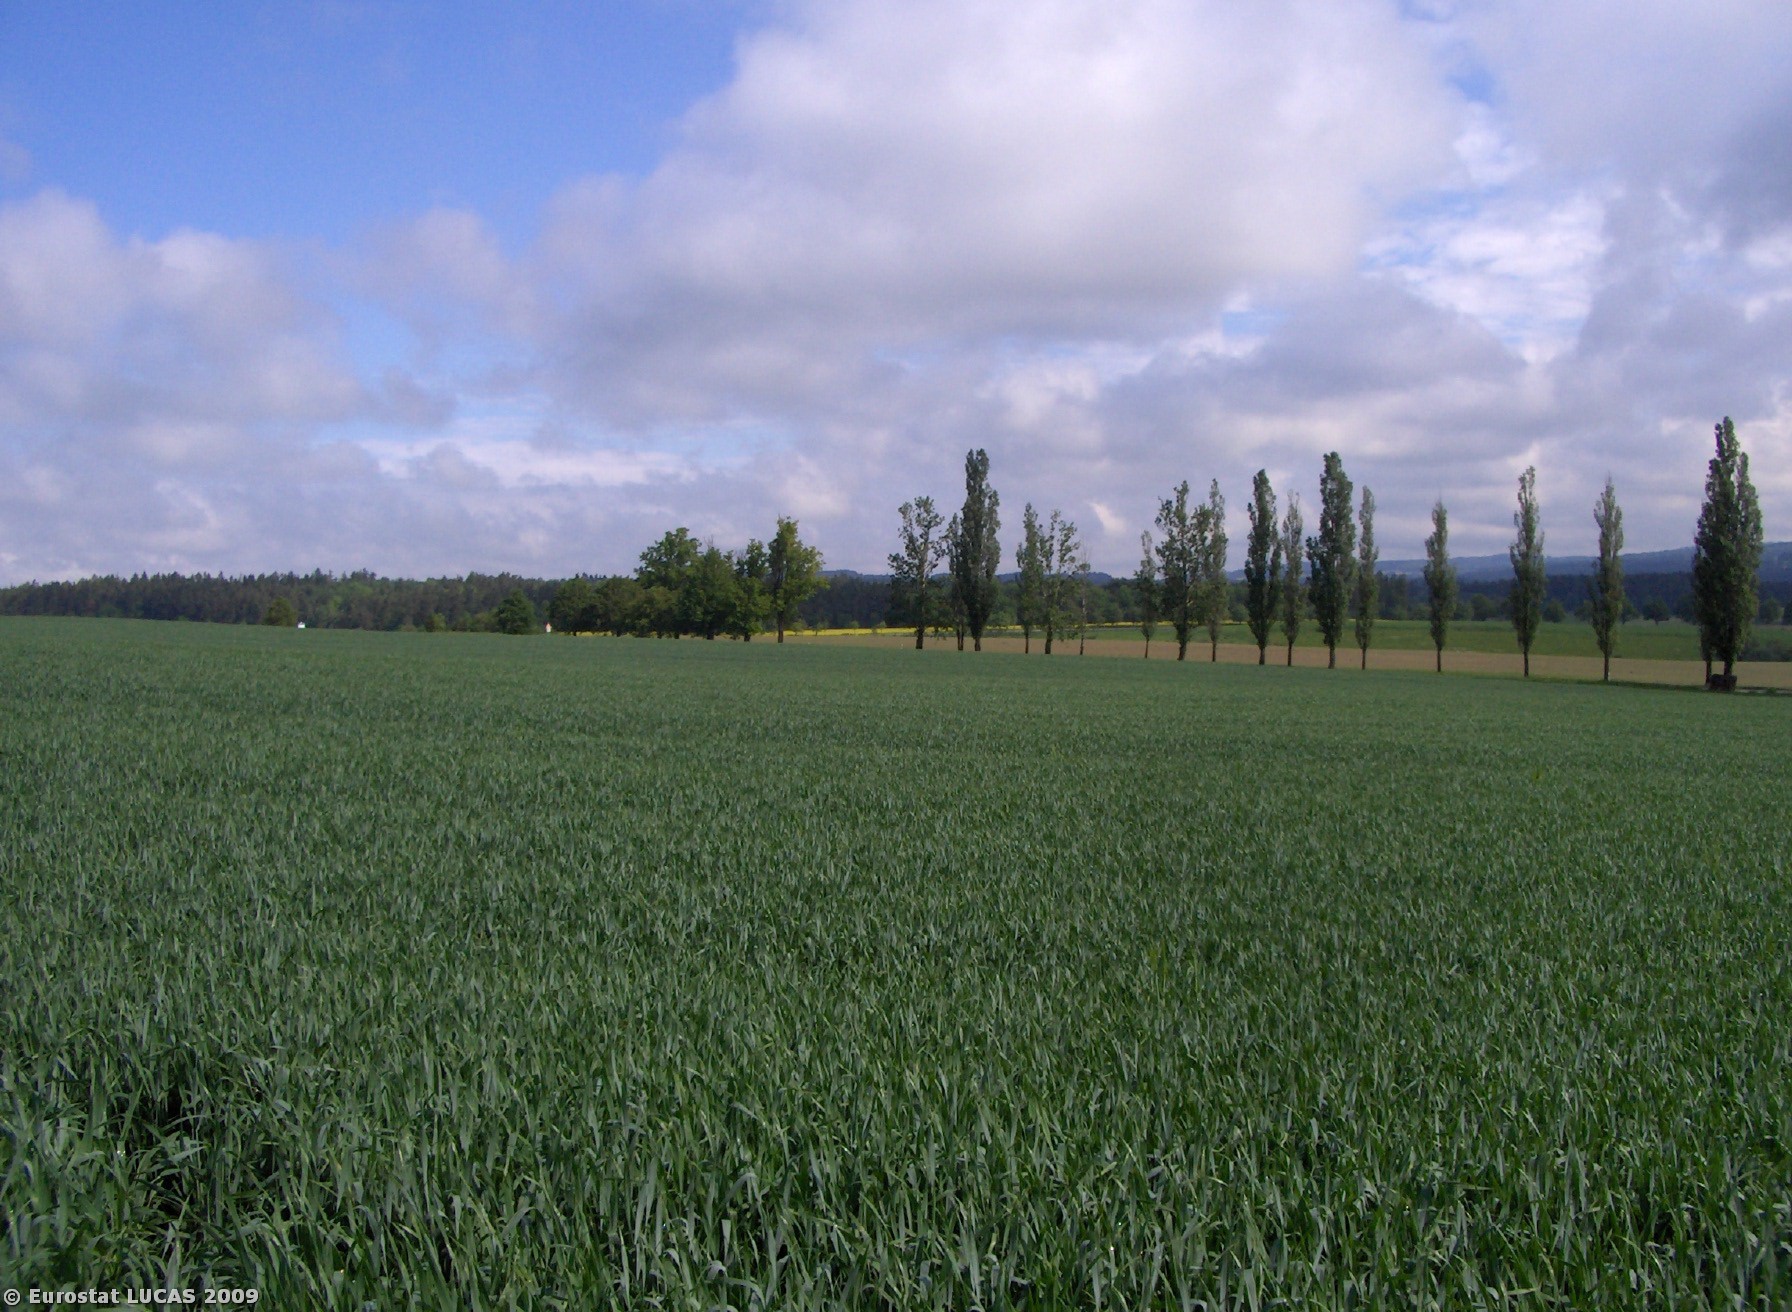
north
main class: Cropland
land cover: Common wheat
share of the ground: > 75 %
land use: Agriculture (excluding fallow land and kitchen gardens)
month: May
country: CZ
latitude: 49.4530
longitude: 14.3465
